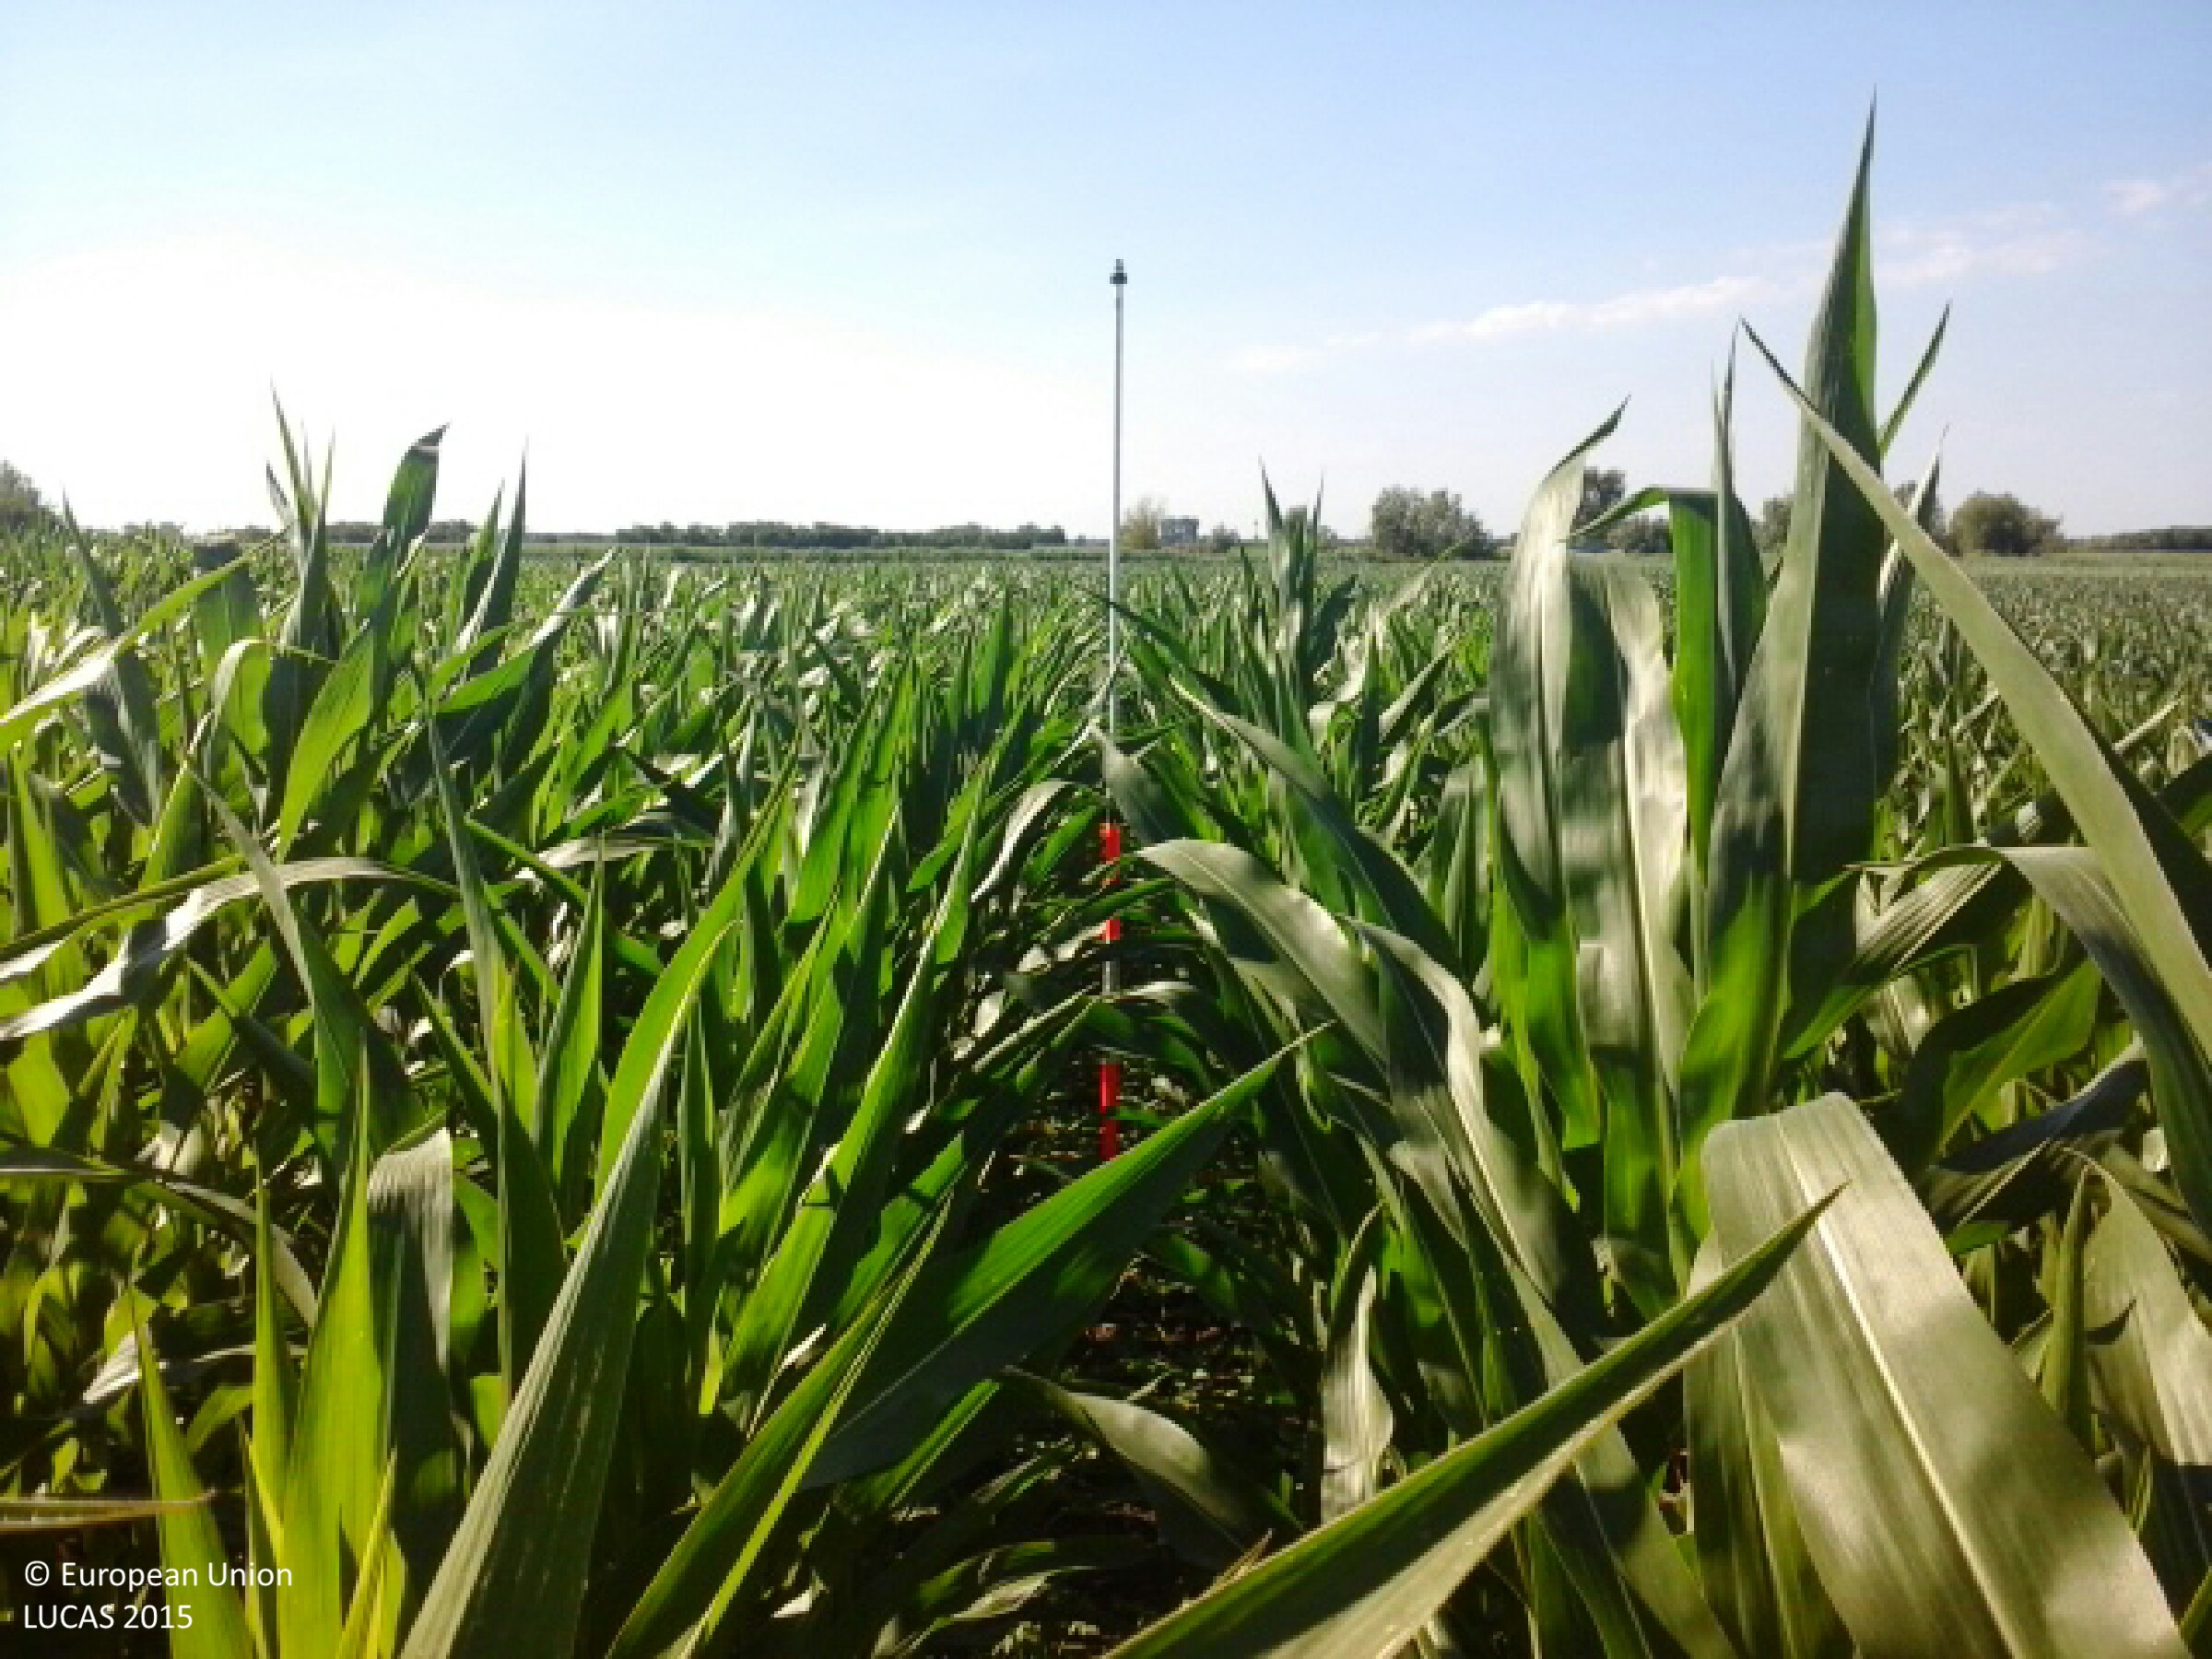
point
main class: Cropland
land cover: Maize
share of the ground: > 75 %
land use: Agriculture (excluding fallow land and kitchen gardens)
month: July
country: HU
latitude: 48.2033
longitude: 21.9877
